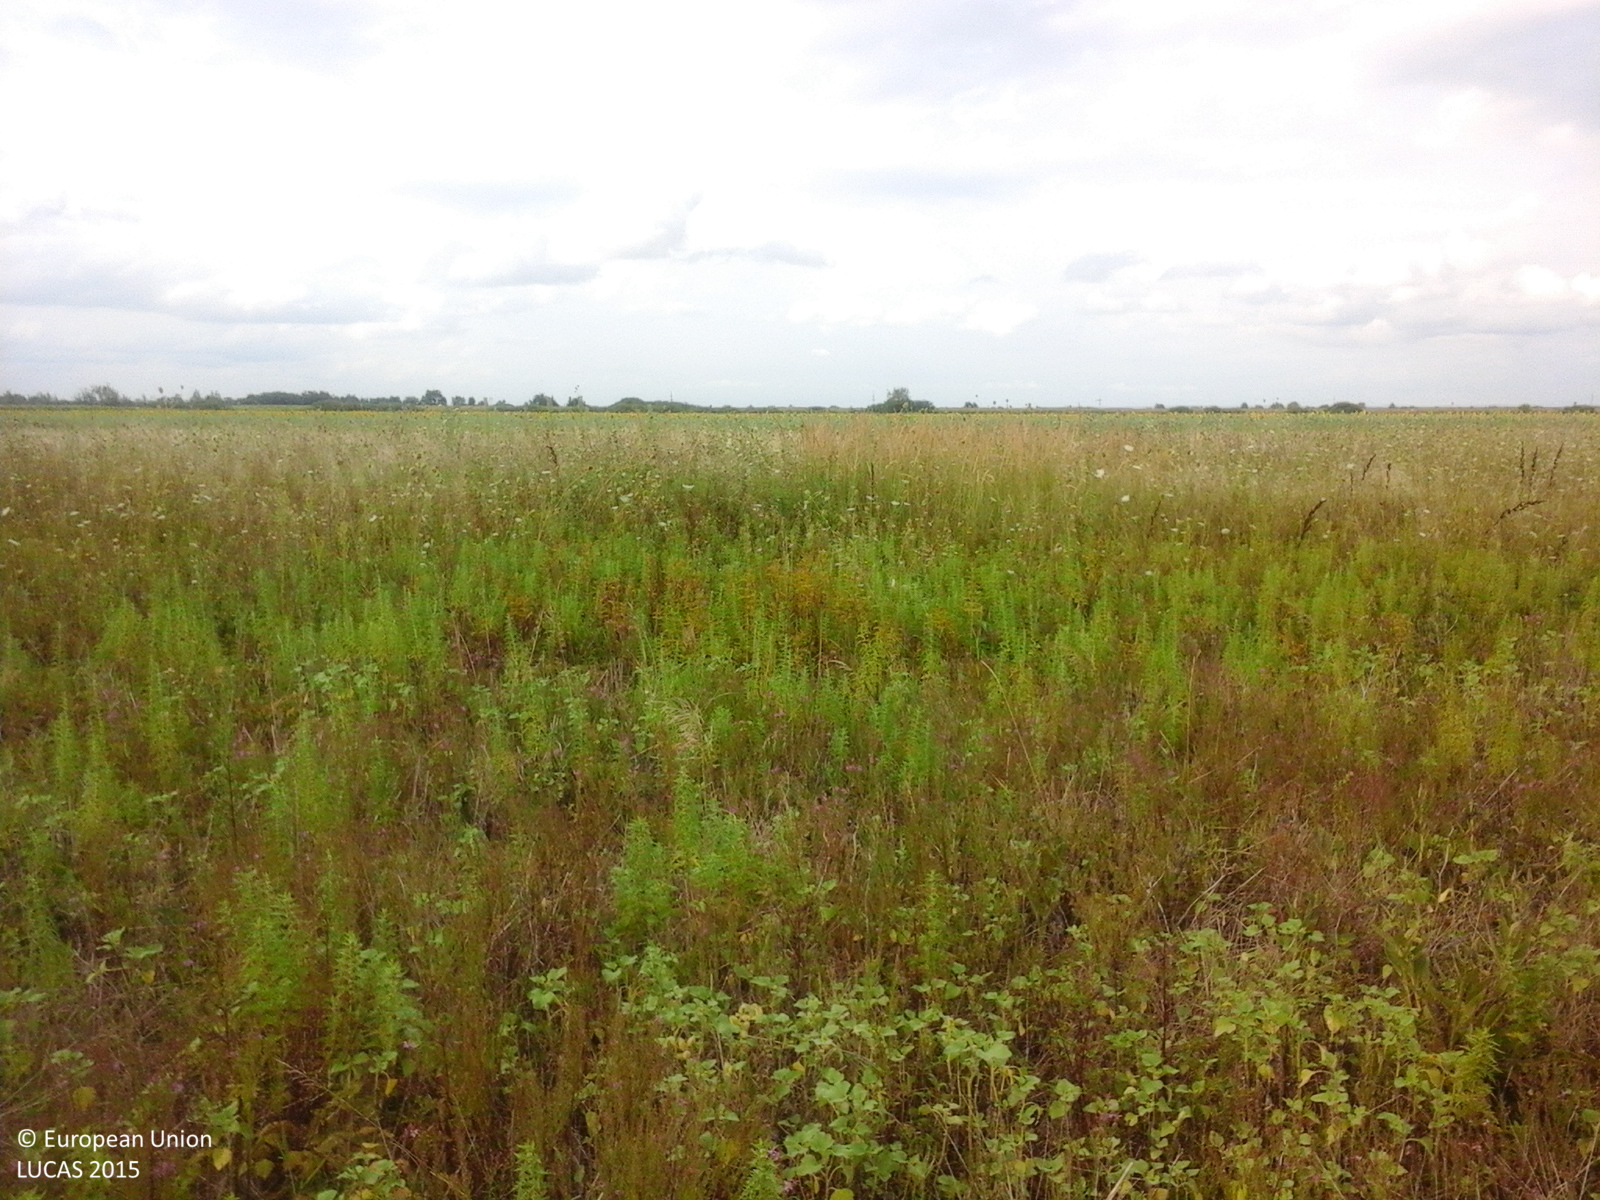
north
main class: Grassland
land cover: Spontaneously vegetated surfaces
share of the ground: > 75 %
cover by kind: herbaceous plants 100 %
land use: Agriculture (excluding fallow land and kitchen gardens)
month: August
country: RO
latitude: 45.6239
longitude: 21.4603
